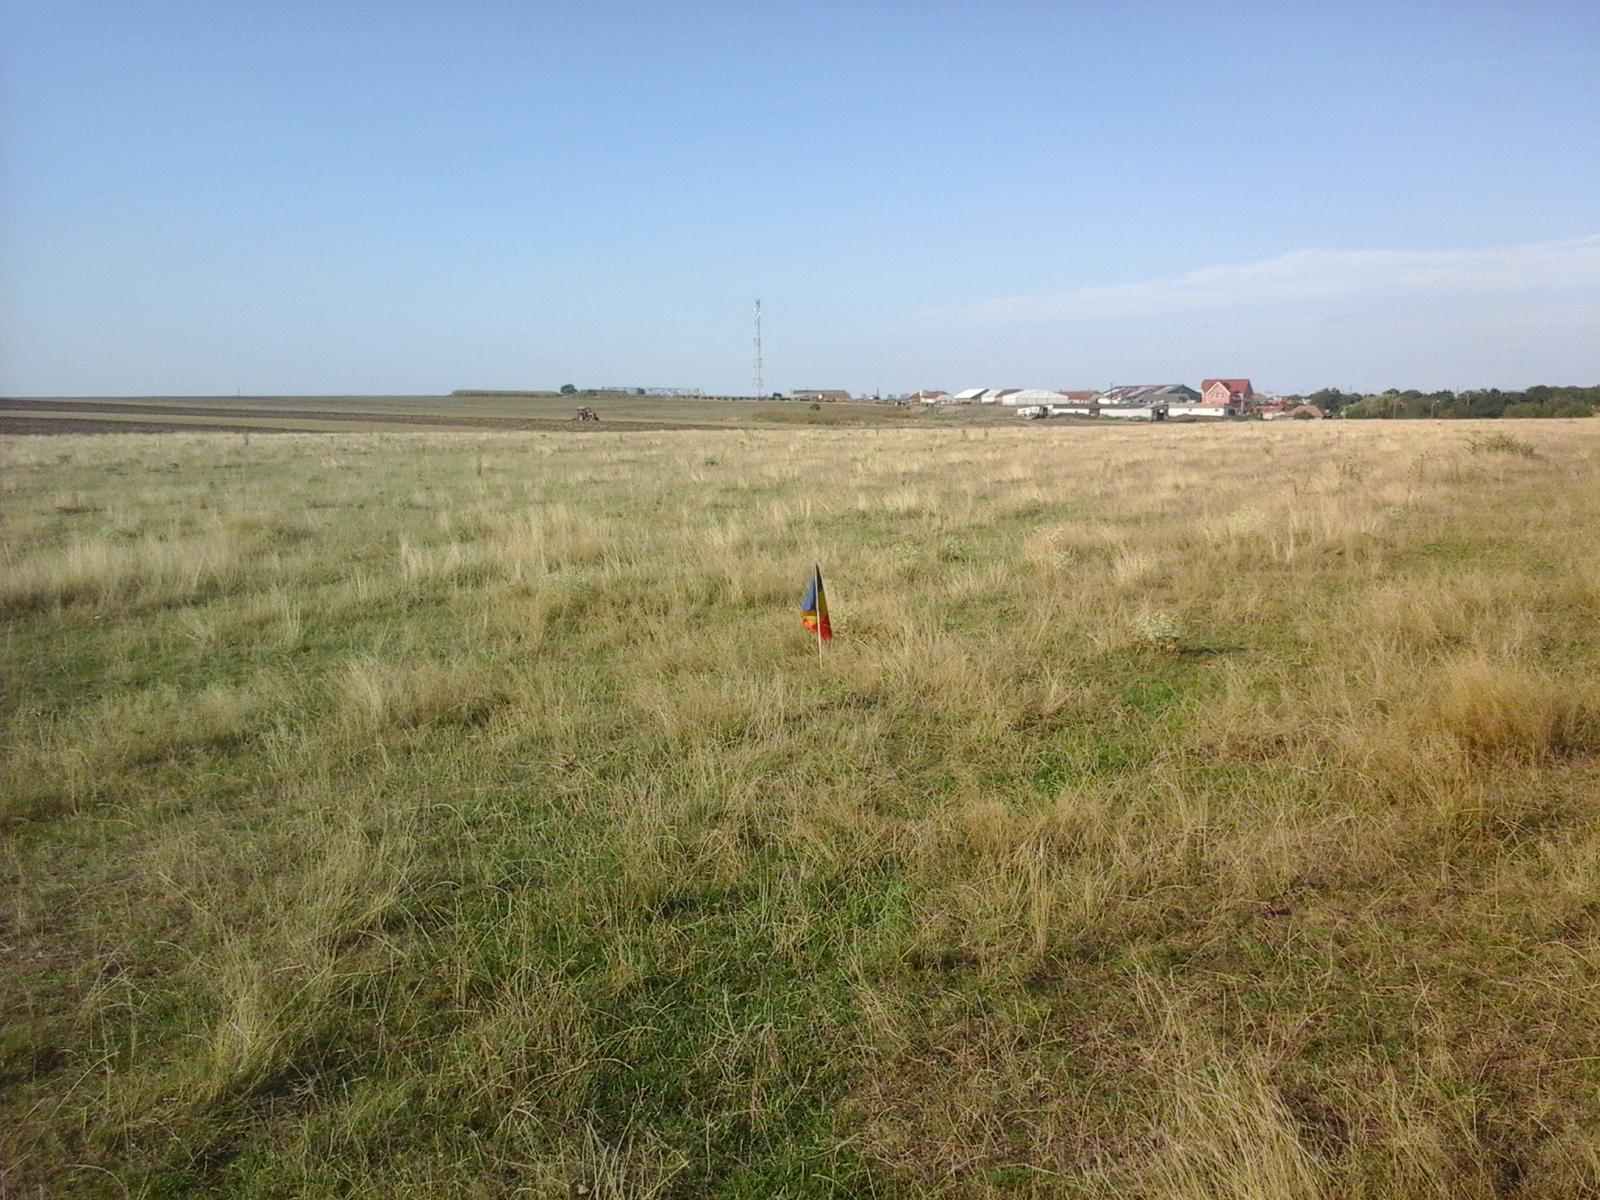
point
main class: Grassland
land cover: Grassland without tree/shrub cover
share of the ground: > 75 %
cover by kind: herbaceous plants 100 %
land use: Agriculture (excluding fallow land and kitchen gardens)
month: August
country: RO
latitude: 46.0165
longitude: 21.3611
